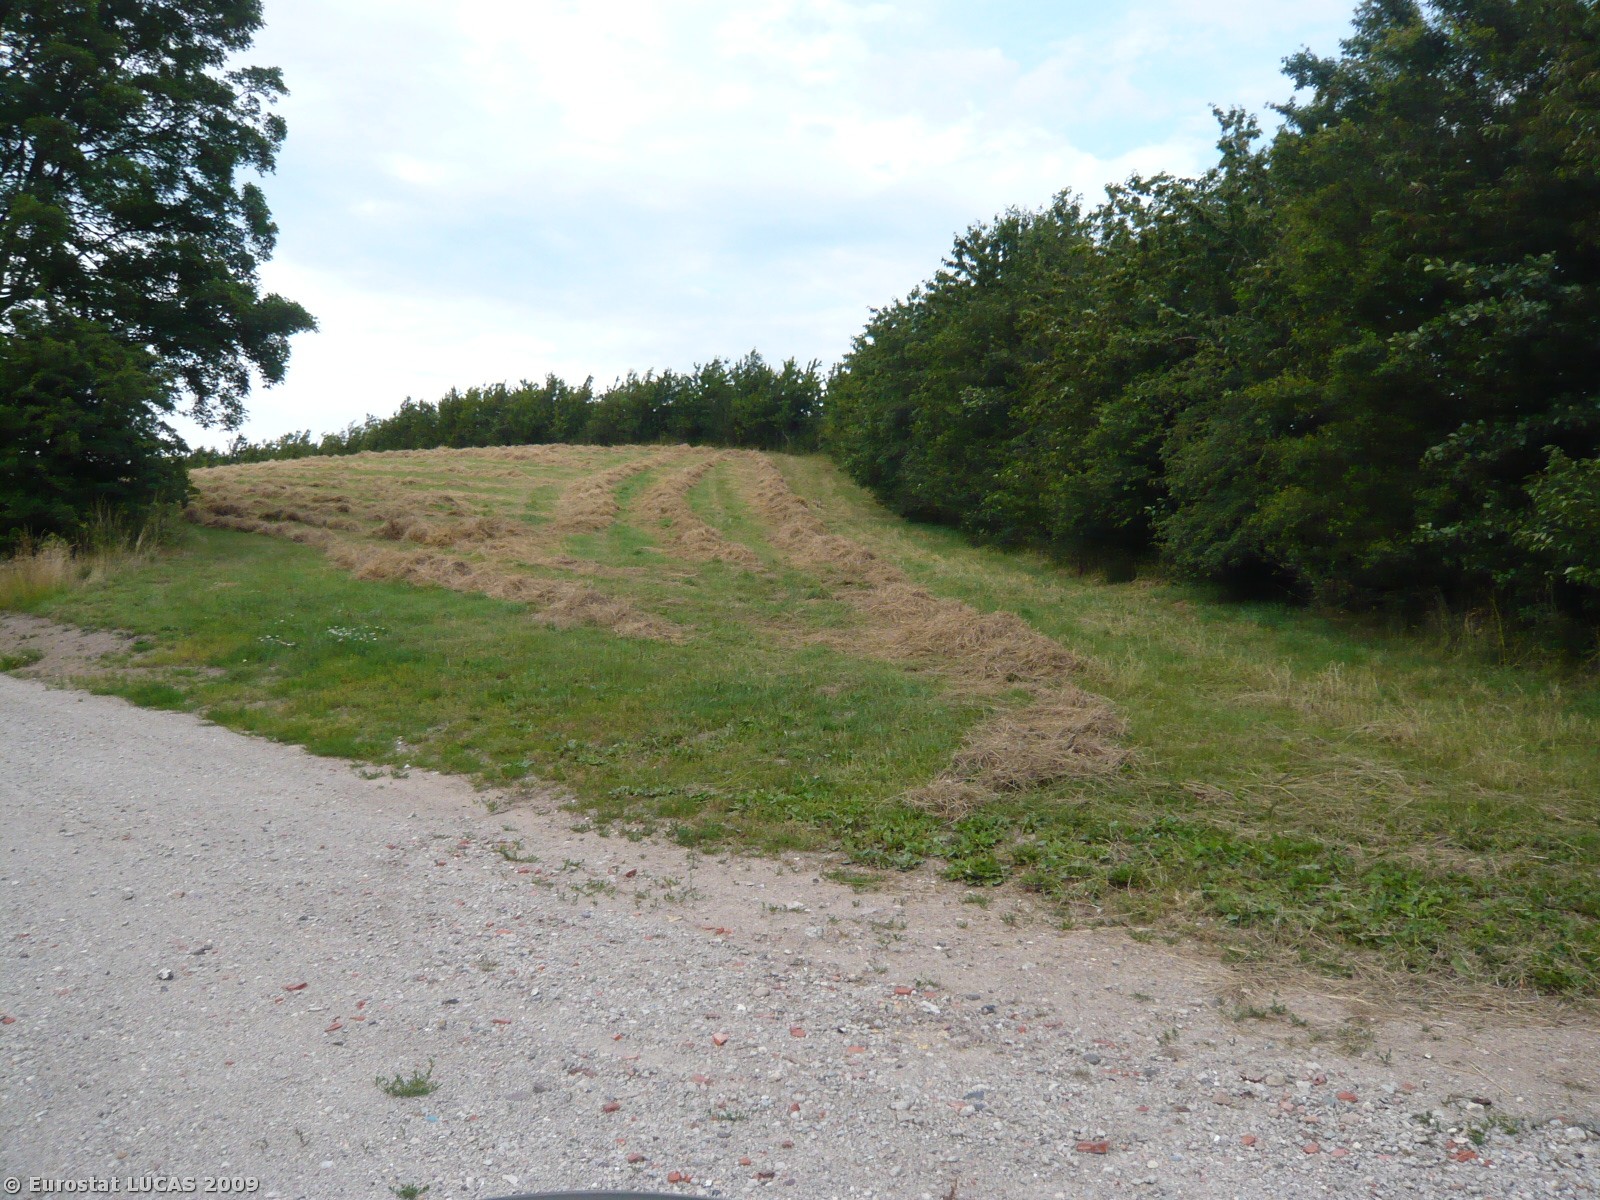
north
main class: Cropland
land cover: Rape and turnip rape
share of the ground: > 75 %
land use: Agriculture (excluding fallow land and kitchen gardens)
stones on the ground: < 10 %
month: July
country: DK
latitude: 55.7308
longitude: 11.3841
